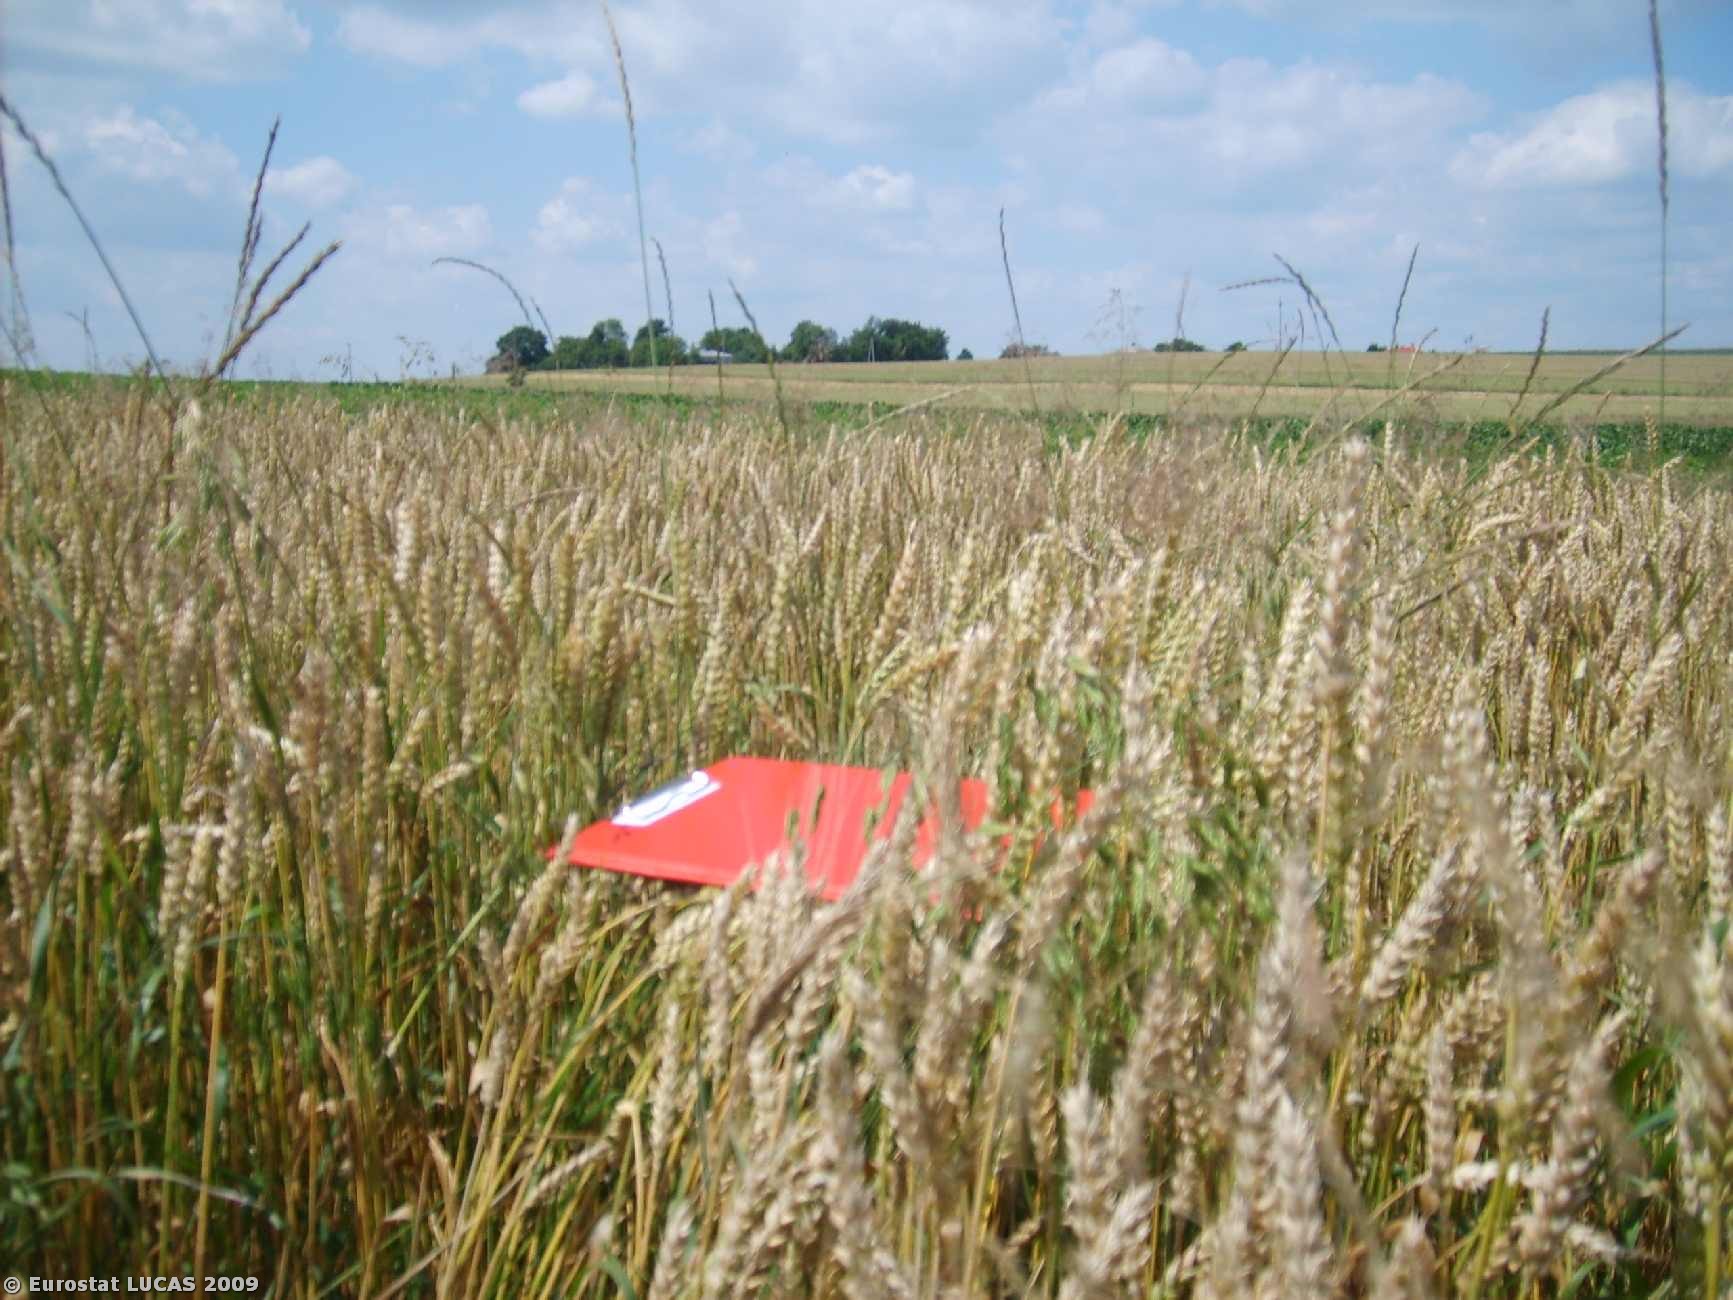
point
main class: Cropland
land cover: Common wheat
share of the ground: > 75 %
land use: Agriculture (excluding fallow land and kitchen gardens)
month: July
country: PL
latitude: 50.5629
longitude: 23.7973
